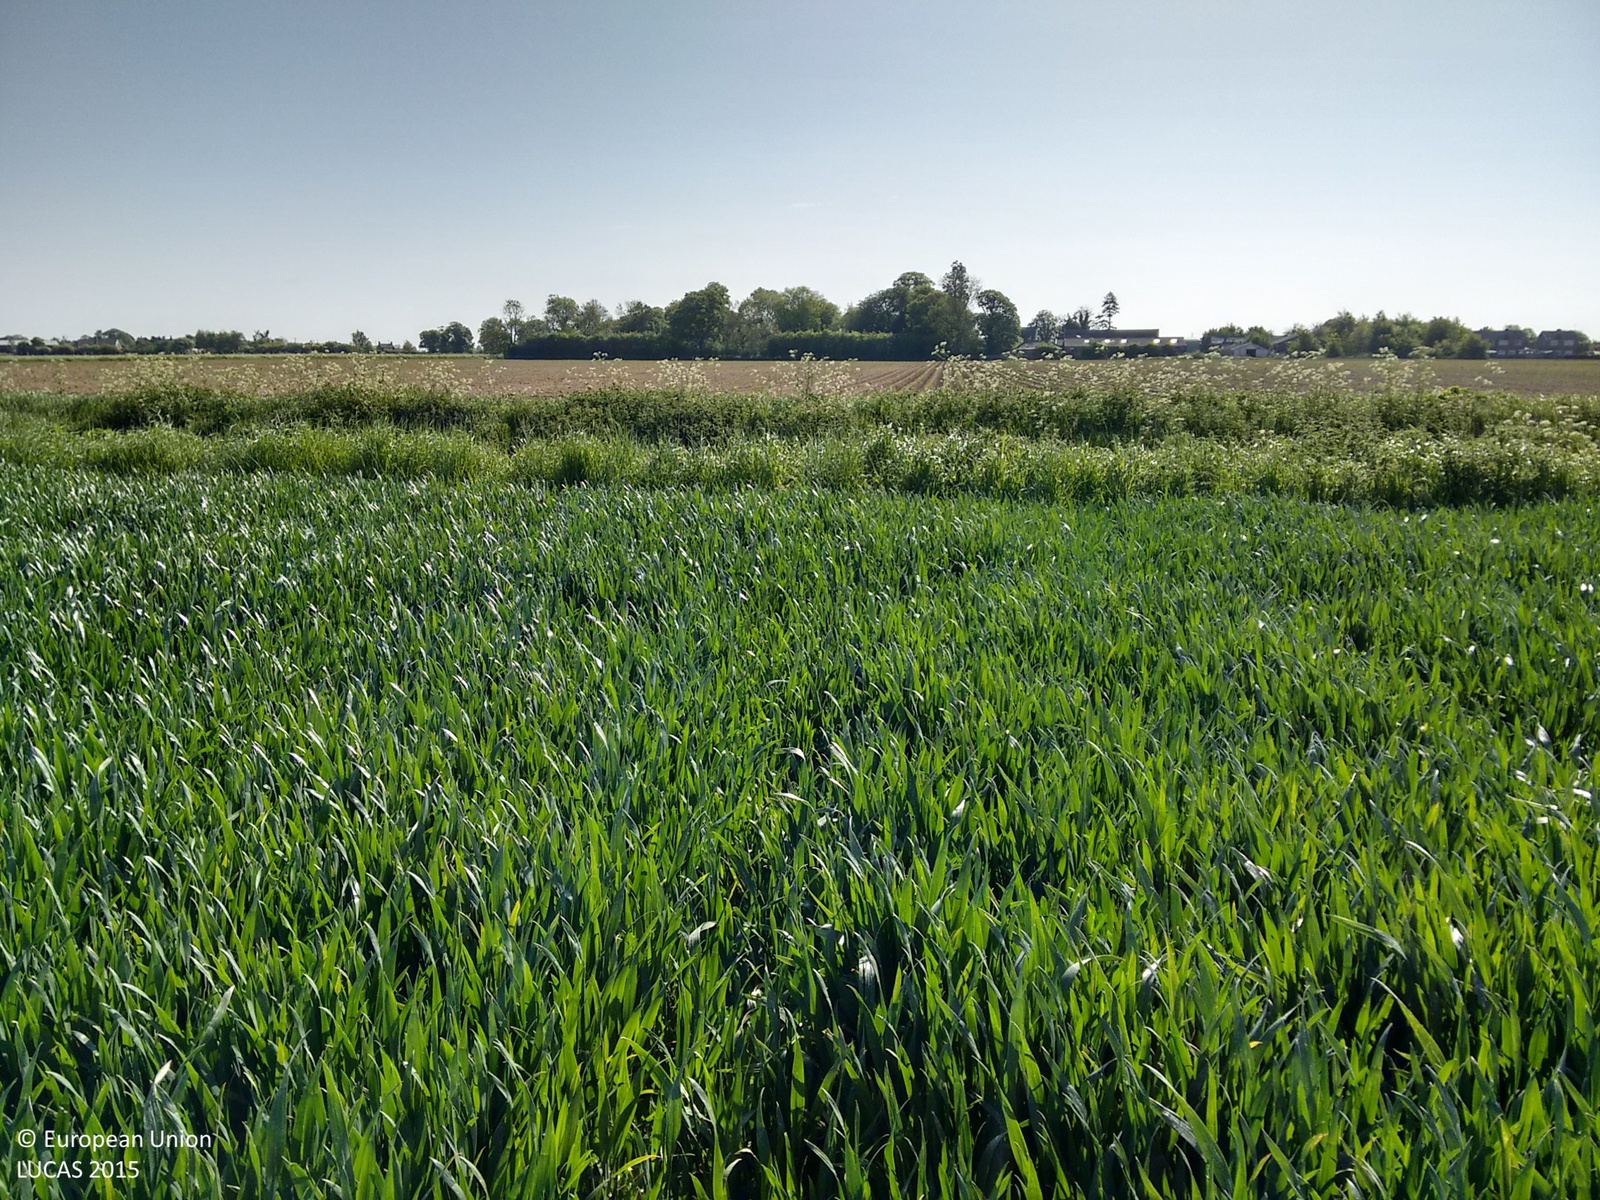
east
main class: Cropland
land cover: Common wheat
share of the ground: > 75 %
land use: Agriculture (excluding fallow land and kitchen gardens)
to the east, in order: Common wheat; Grass margins; Ditches and canals; Grass margins; Potatoes
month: May
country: GB
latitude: 52.7971
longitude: -0.1037
